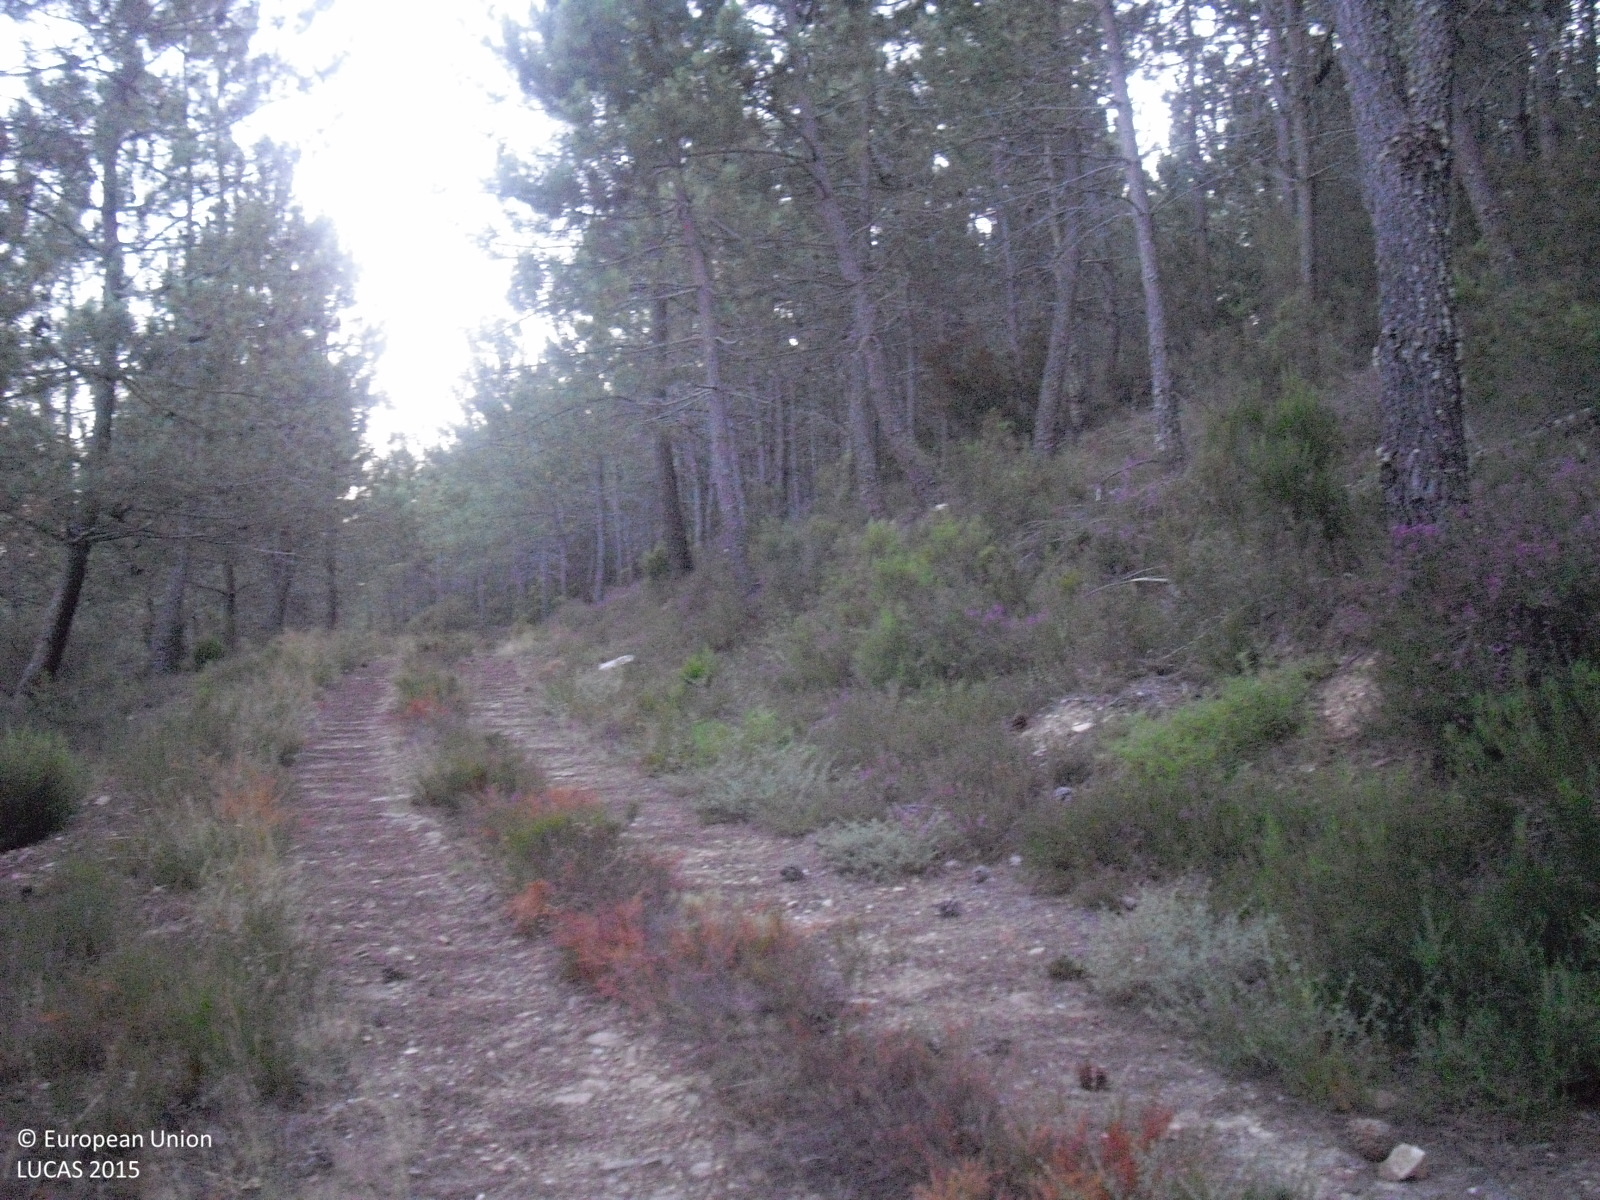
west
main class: Woodland
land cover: Pine dominated coniferous woodland
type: hemiboreal forest and nemoral coniferous forest and mixed broadleaved-coniferous forest
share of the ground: 50 - 75 %
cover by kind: coniferous forest trees 70 %, shrubs 30 %
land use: Forestry
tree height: > 5 m
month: July
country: ES
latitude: 42.5569
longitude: -7.2735
